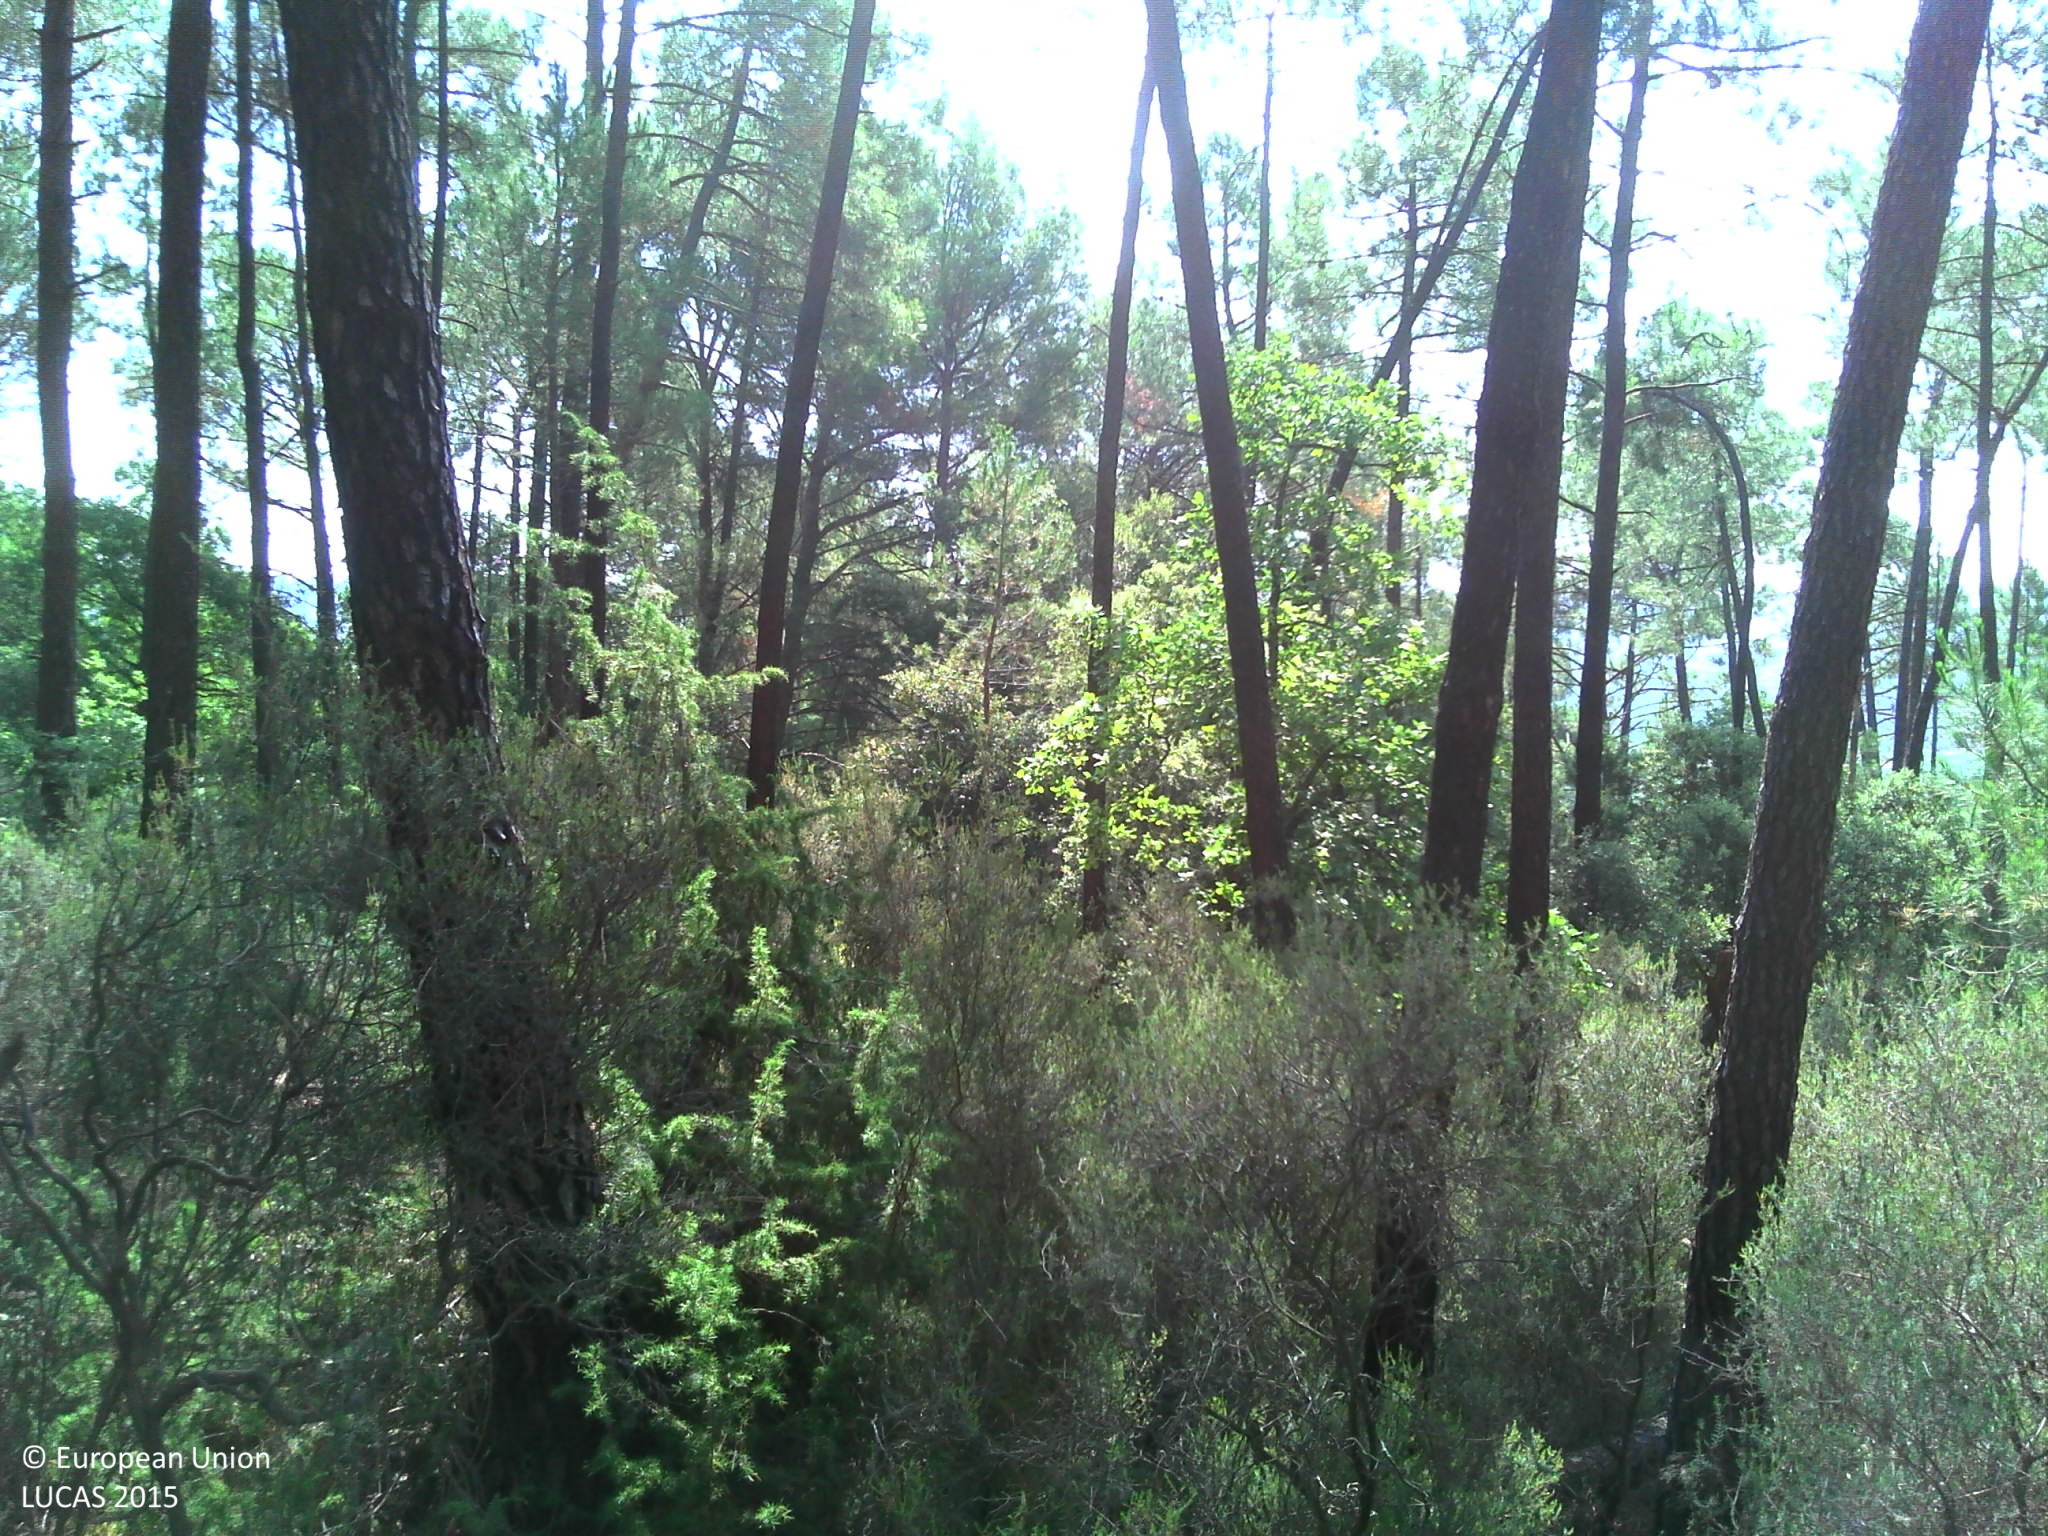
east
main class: Woodland
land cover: Pine dominated coniferous woodland
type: coniferous forest of the mediterranean region
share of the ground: > 75 %
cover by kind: coniferous forest trees 75 %, shrubs 15 %, herbaceous plants 10 %
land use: Forestry
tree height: > 5 m
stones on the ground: 10 - 25 %
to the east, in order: Pine dominated coniferous woodland; Tracks; Pine dominated coniferous woodland; Pine dominated mixed woodland; Cherry fruit
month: July
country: FR
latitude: 44.0781
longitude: 5.2256
